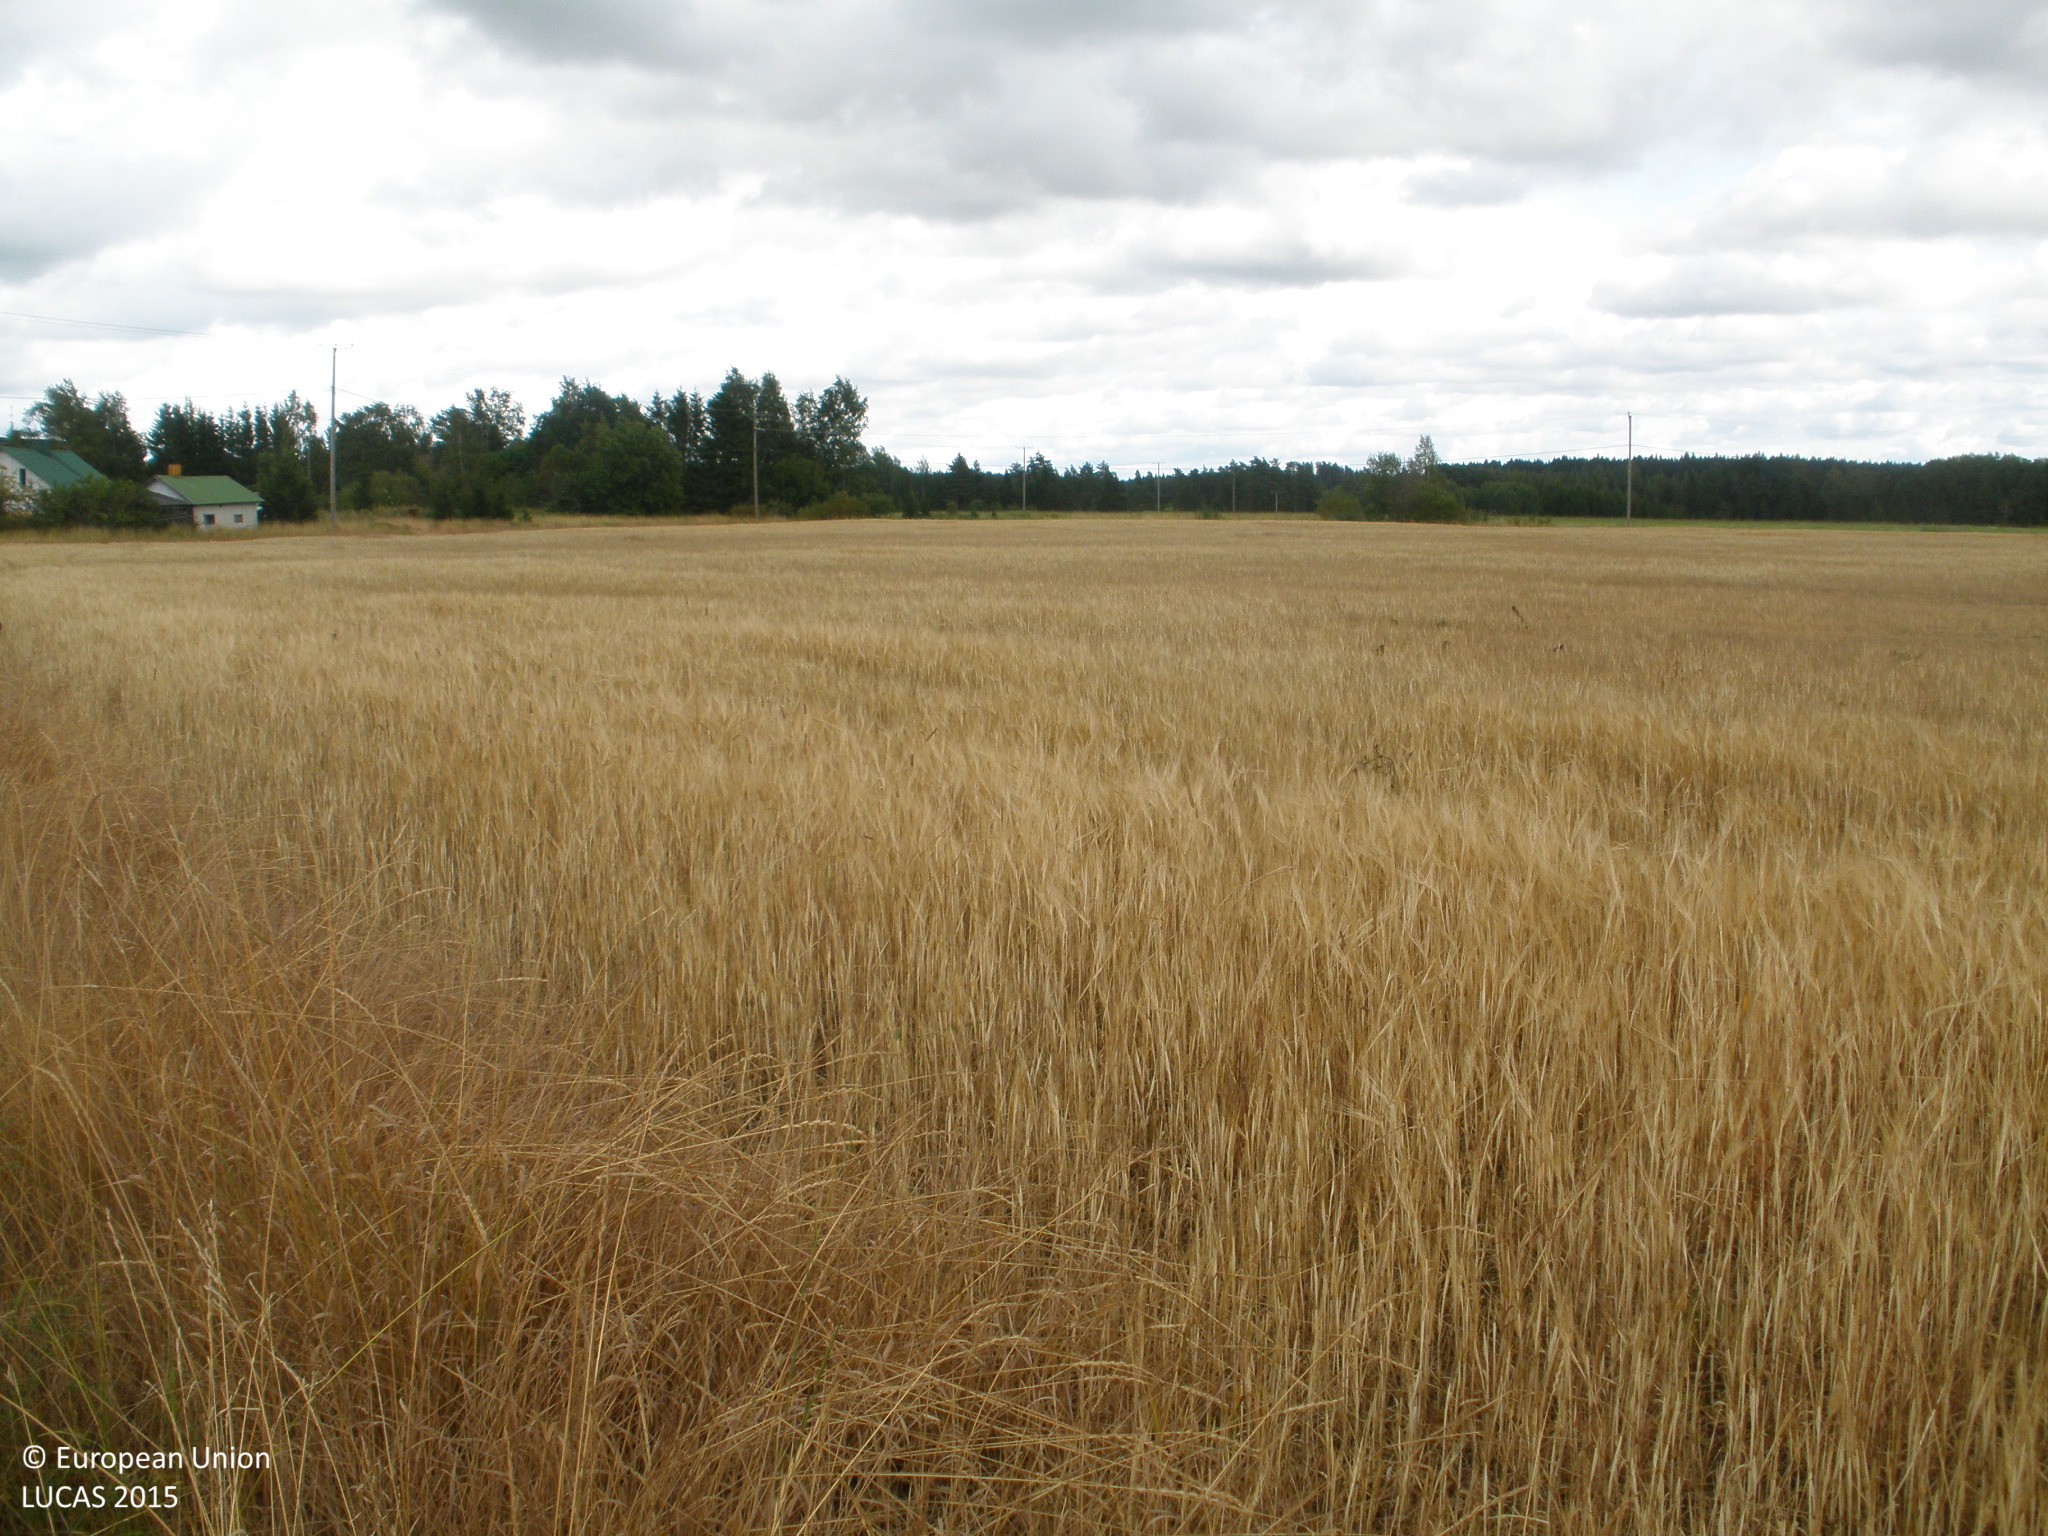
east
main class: Cropland
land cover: Barley
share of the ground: 50 - 75 %
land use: Agriculture (excluding fallow land and kitchen gardens)
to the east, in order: Barley; Electric lines; Grass margins; Ditches and canals; Grass margins; Tracks; Grass margins; Ditches and canals; Grassland without tree/shrub cover; Ditches and canals; Grass margins; Oats
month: August
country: FI
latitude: 60.5817
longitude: 23.3894
